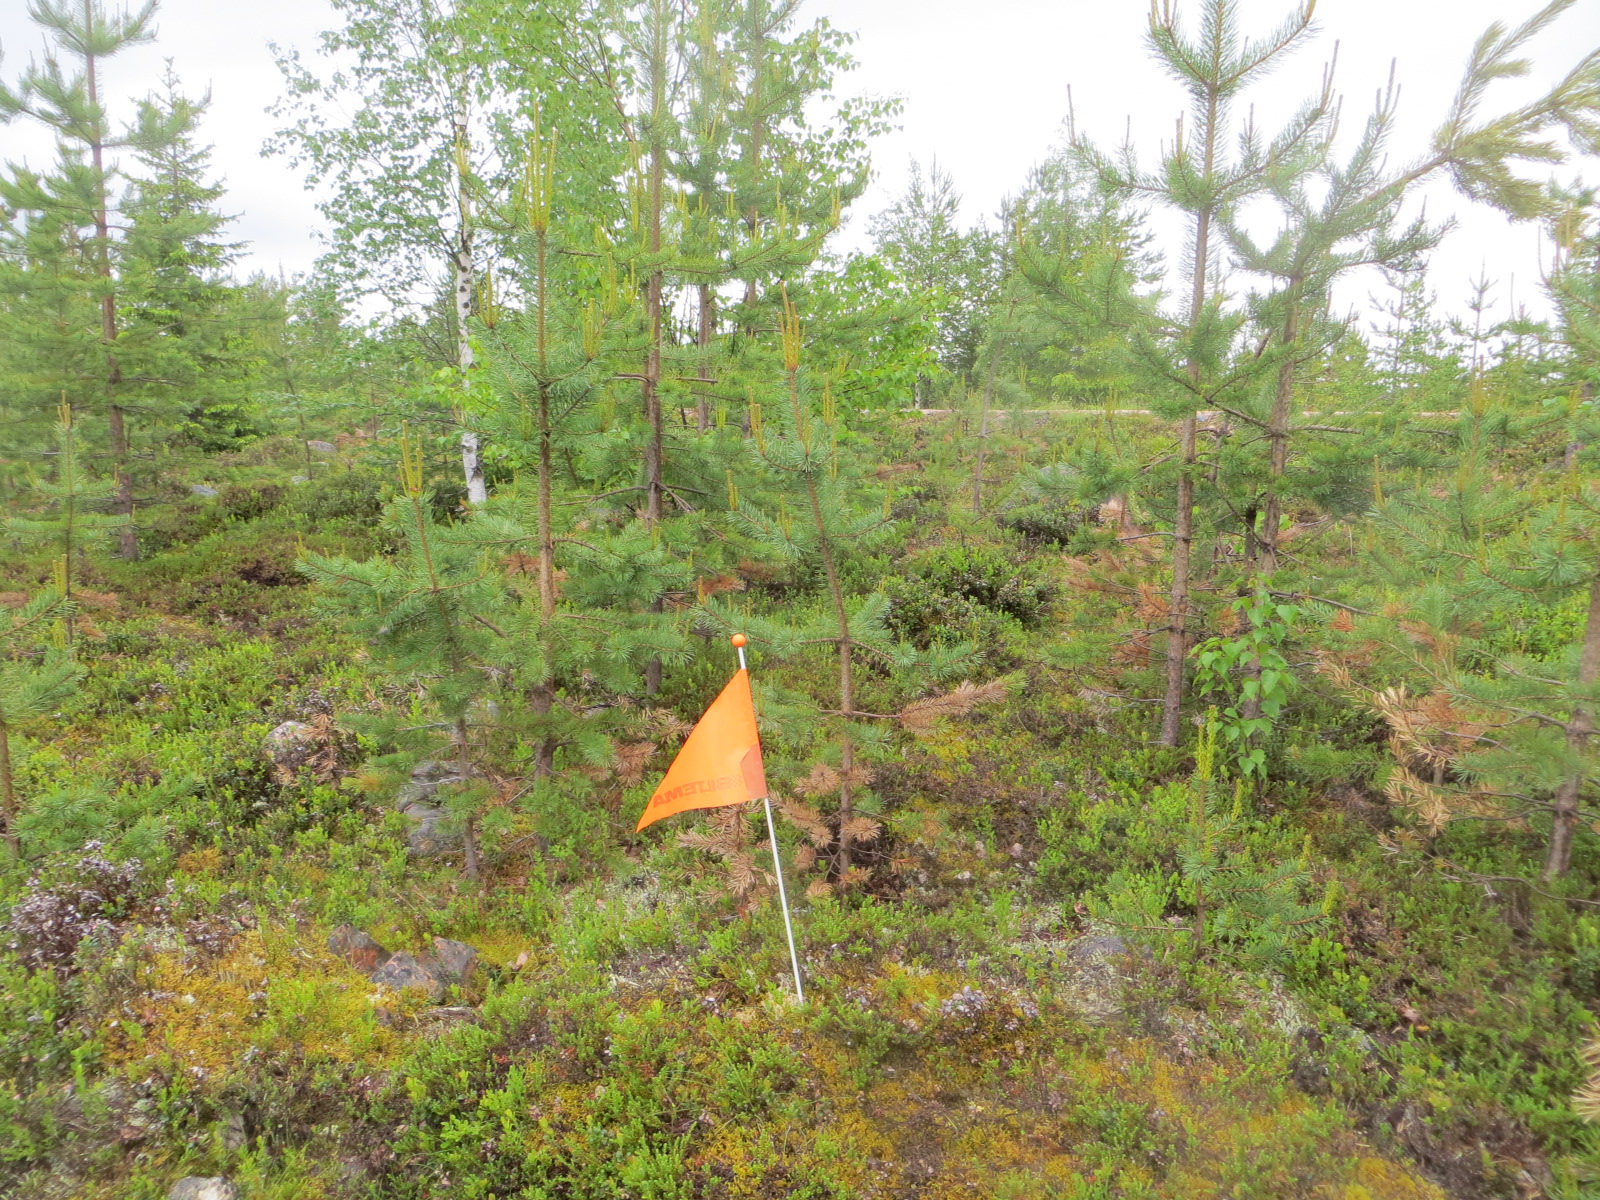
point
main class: Woodland
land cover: Pine dominated mixed woodland
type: boreal forest
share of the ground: 50 - 75 %
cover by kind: coniferous forest trees 45 %, broadleaved forest trees 25 %, shrubs 20 %, lichens and mosses 10 %
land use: Forestry
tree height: < 5 m
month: June
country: FI
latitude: 66.0249
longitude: 26.9332
